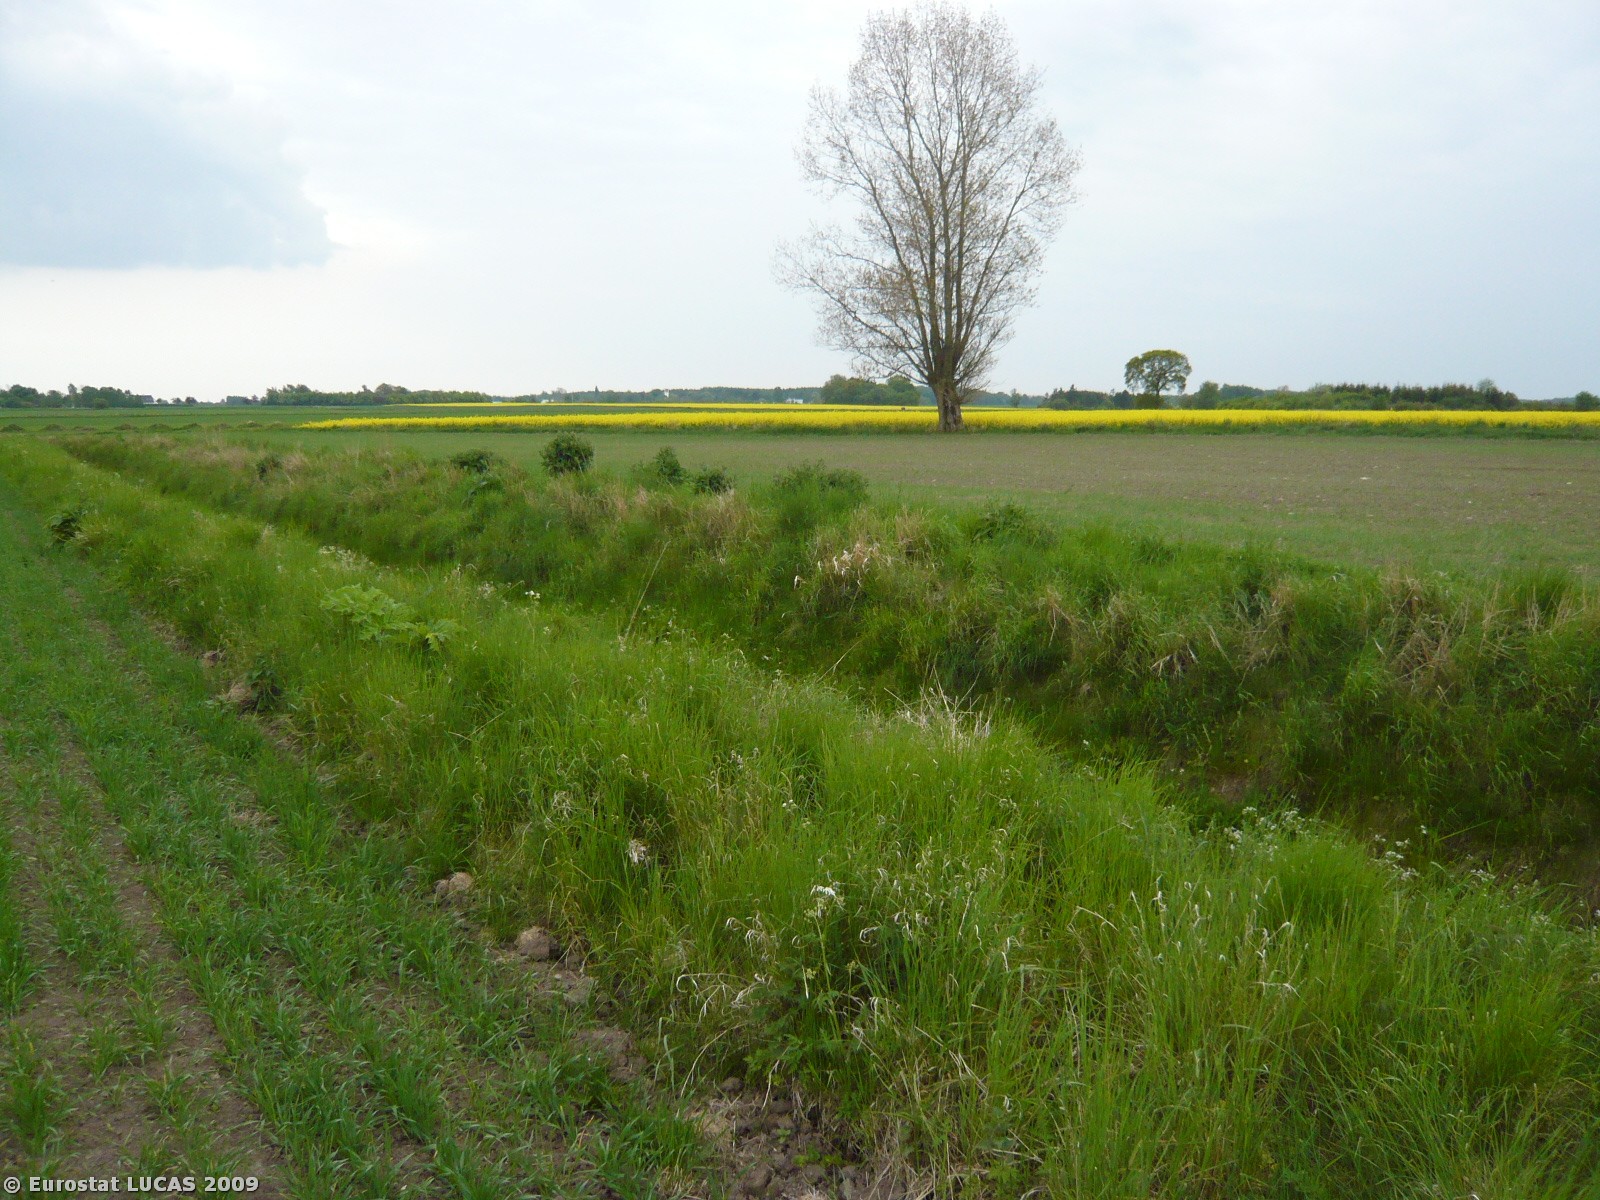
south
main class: Cropland
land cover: Barley
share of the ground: 50 - 75 %
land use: Agriculture (excluding fallow land and kitchen gardens)
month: May
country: DK
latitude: 55.3604
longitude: 12.1595
